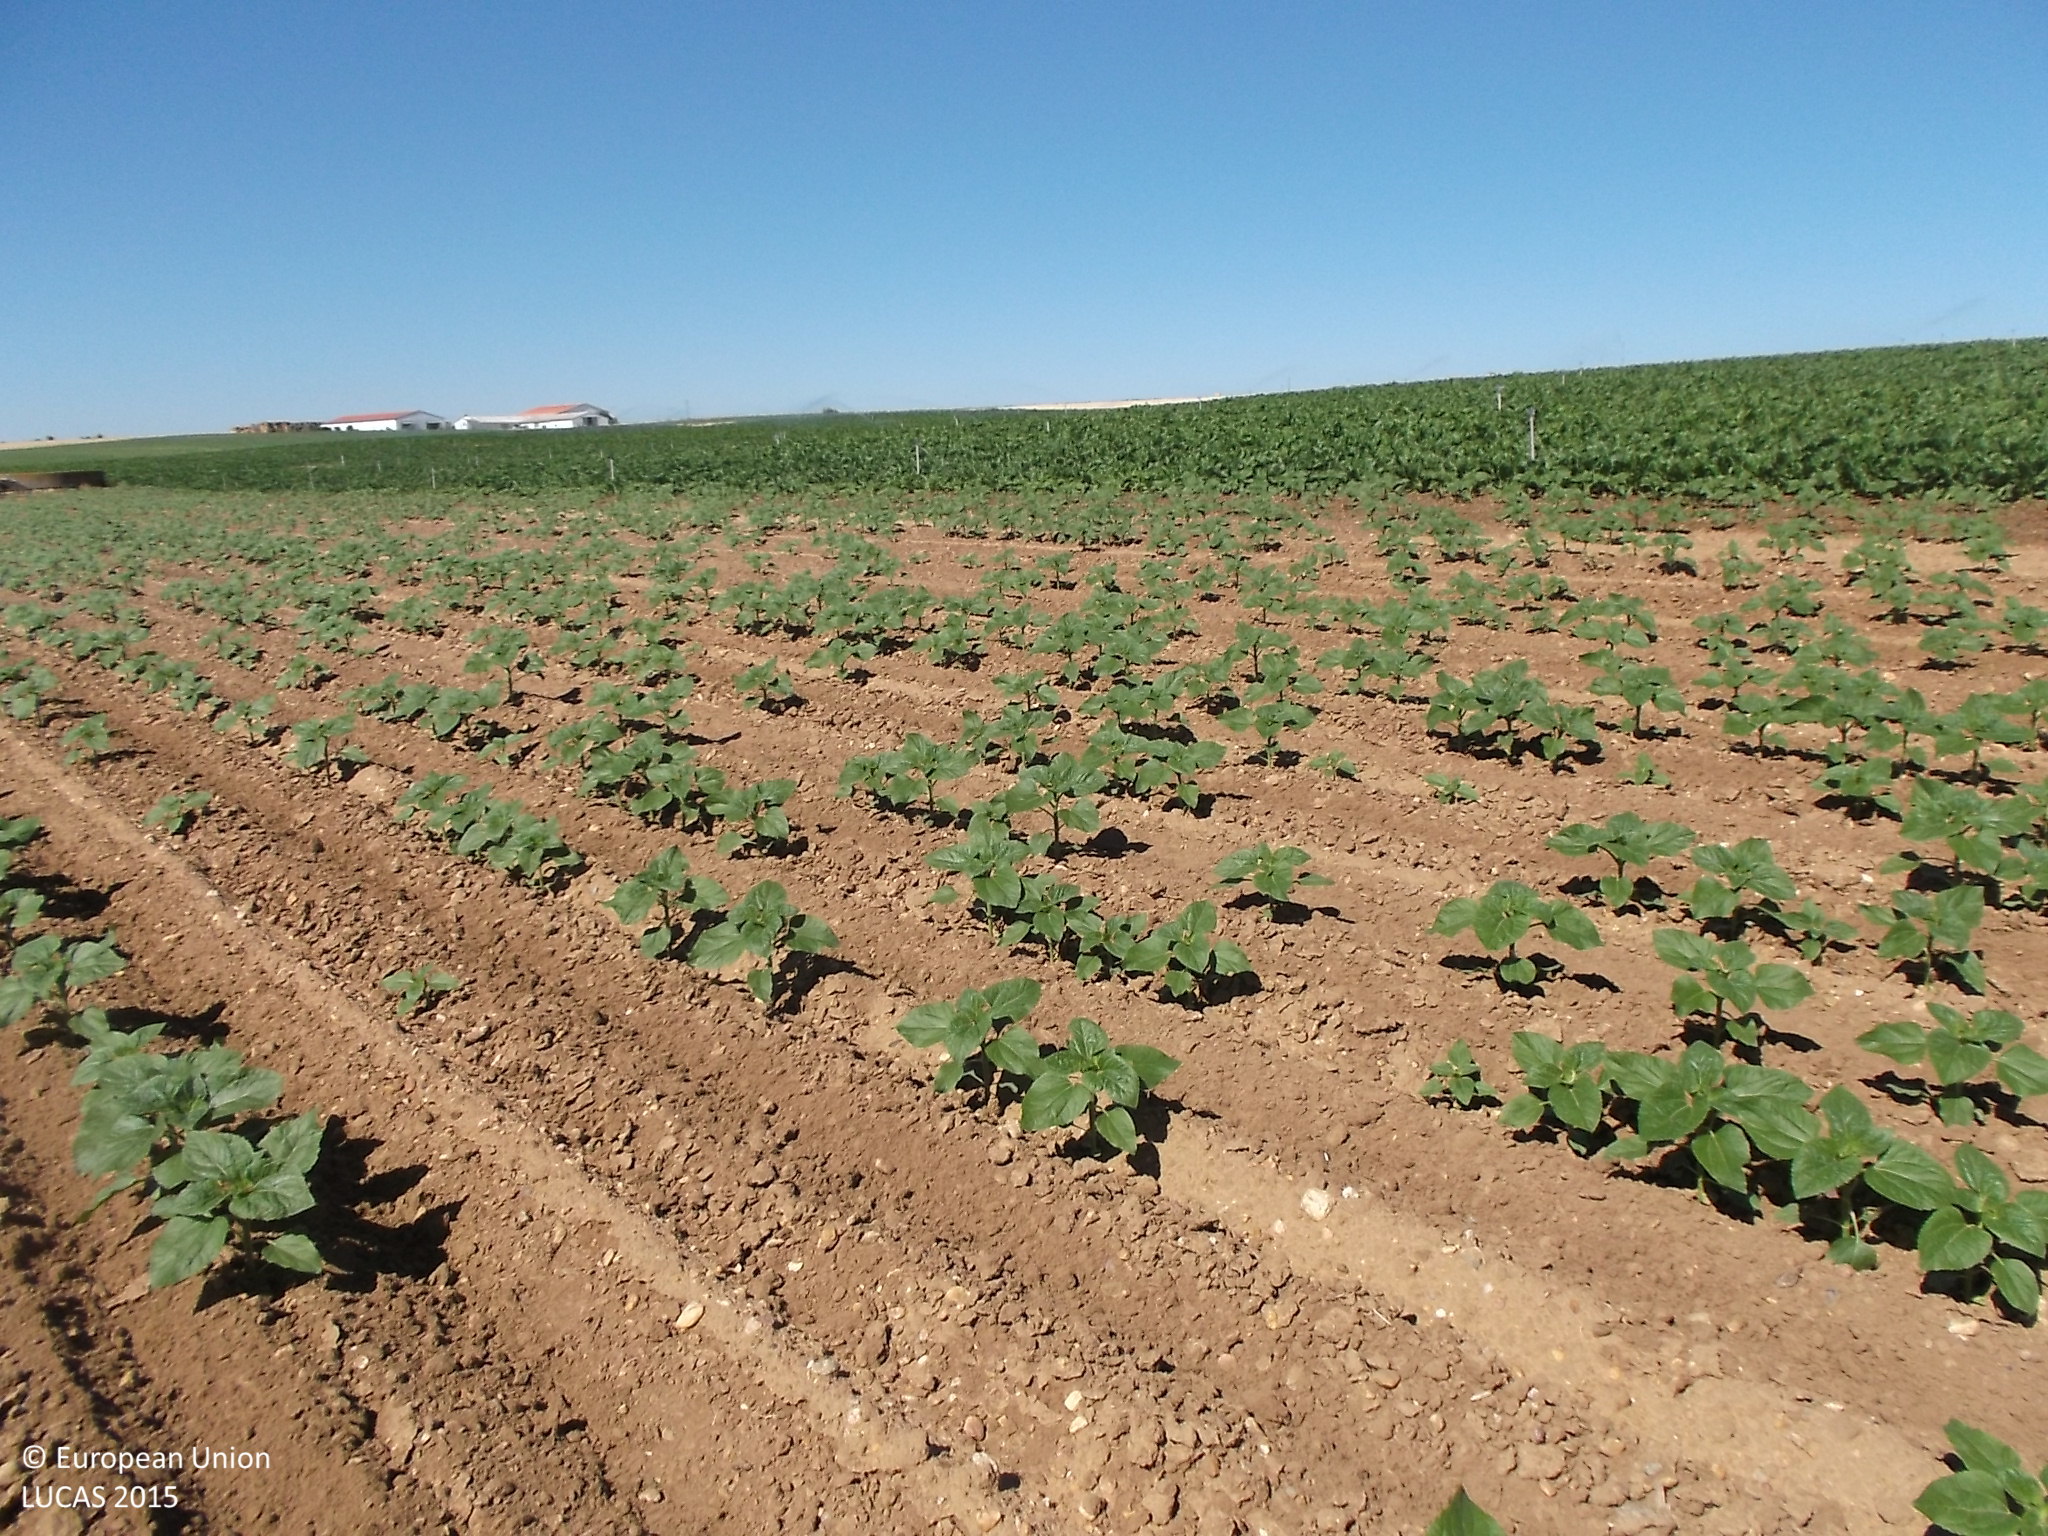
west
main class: Cropland
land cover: Sunflower
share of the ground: 50 - 75 %
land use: Agriculture (excluding fallow land and kitchen gardens)
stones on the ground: < 10 %
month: June
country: ES
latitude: 41.2535
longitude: -5.3634
